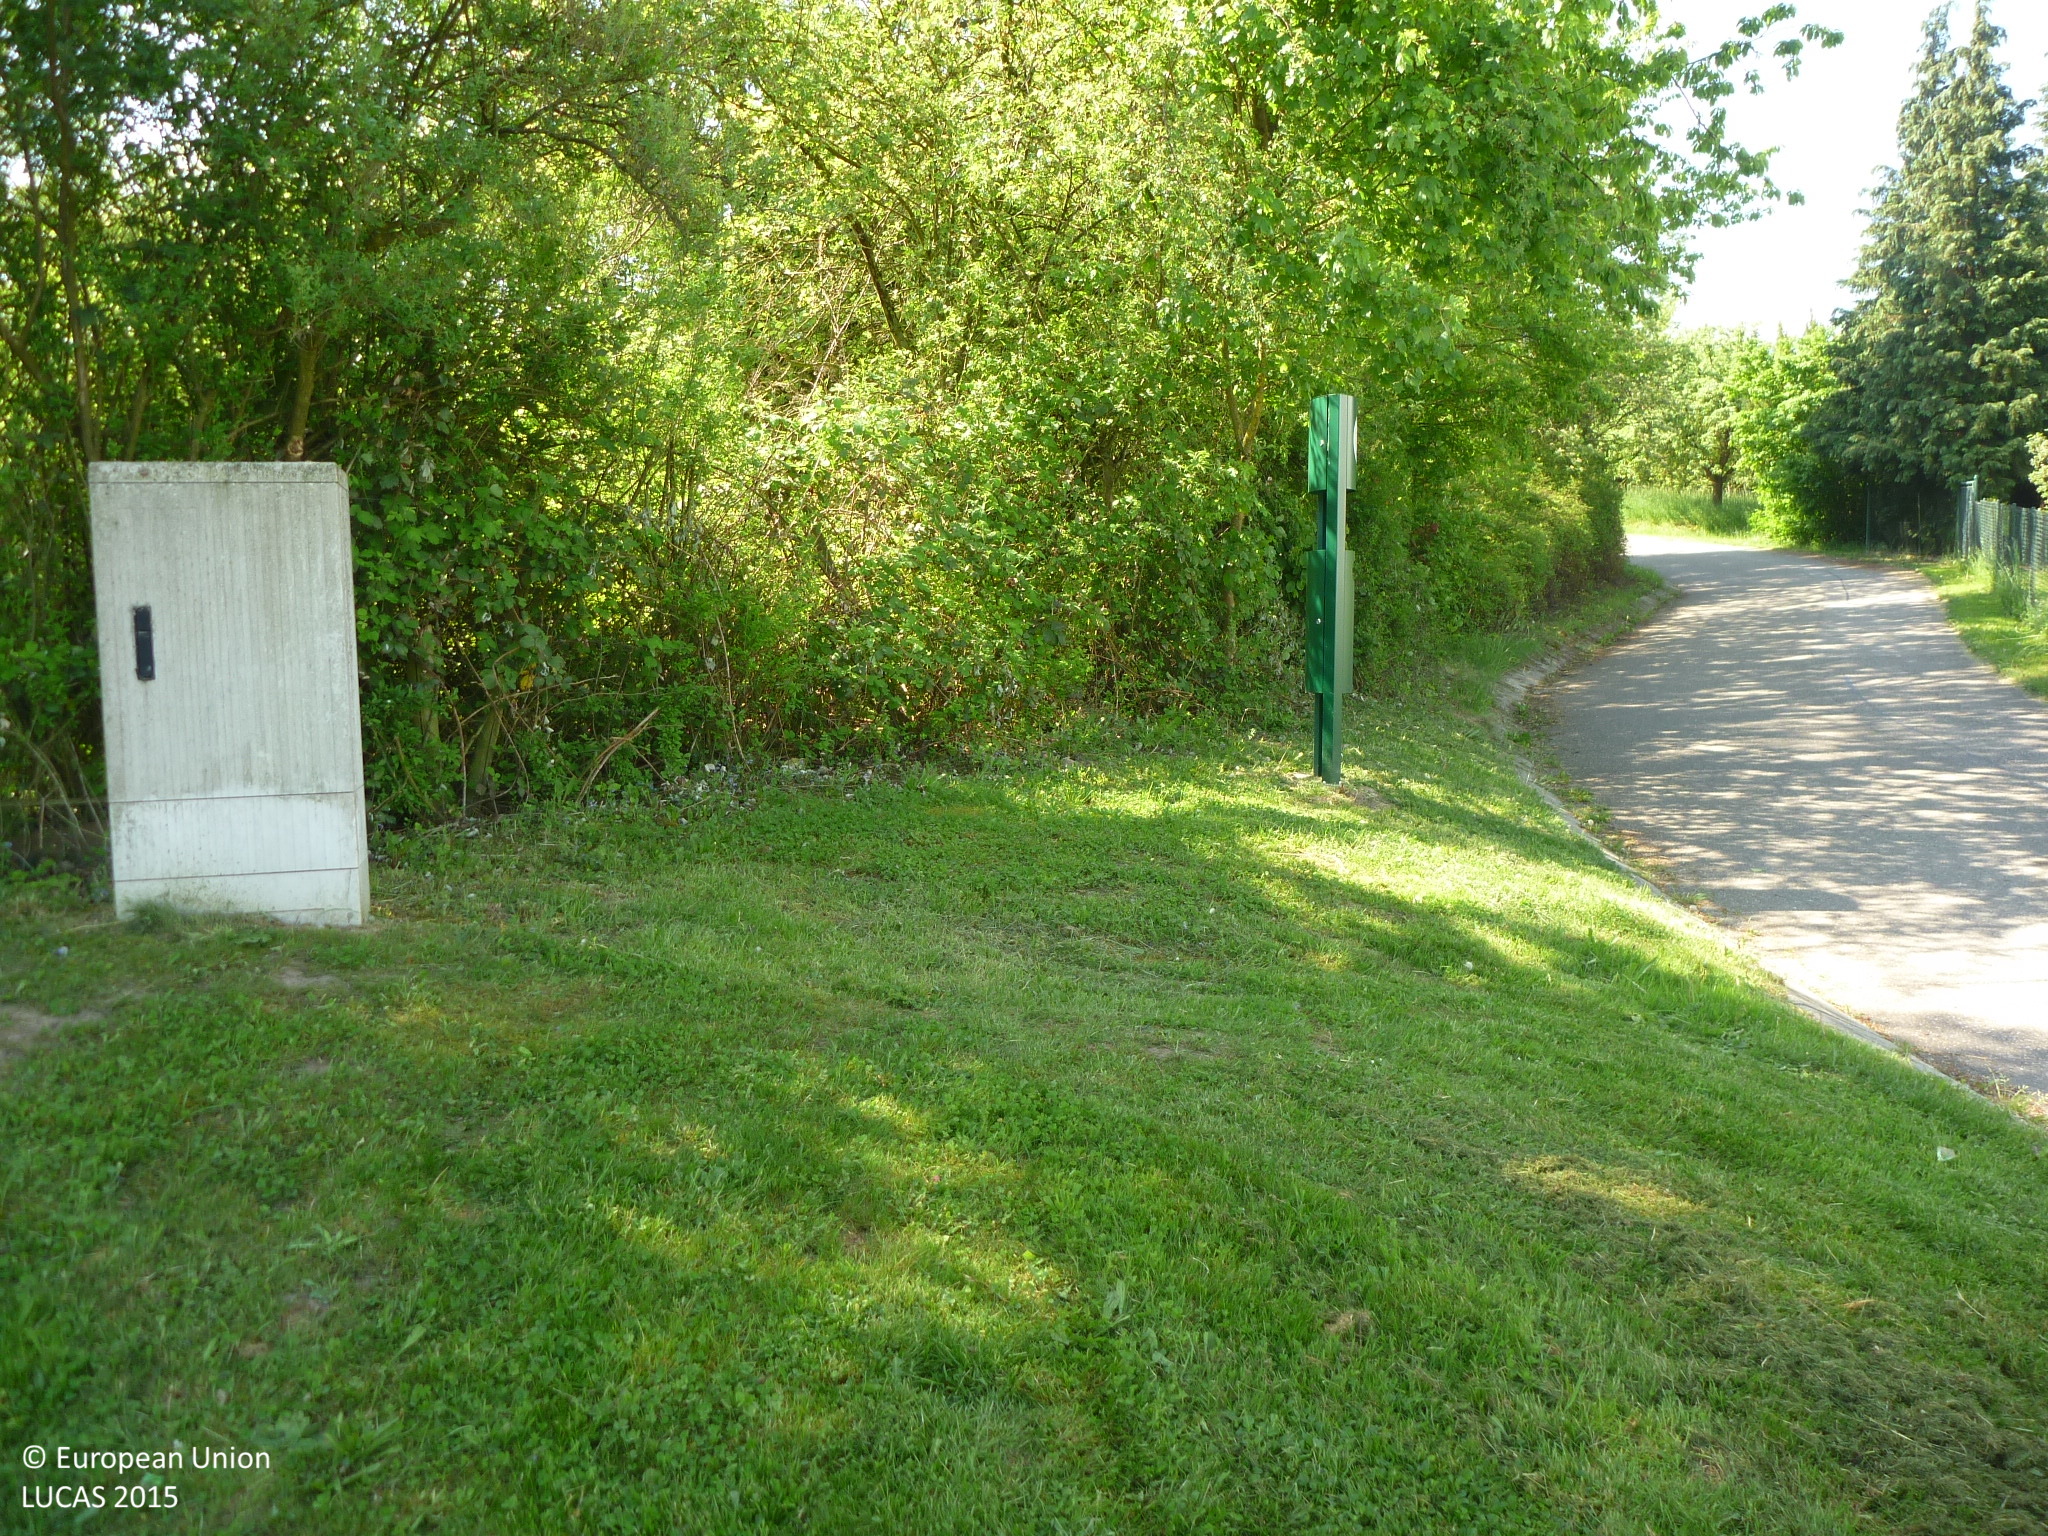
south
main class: Grassland
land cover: Grassland without tree/shrub cover
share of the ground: > 75 %
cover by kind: herbaceous plants 100 %
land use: Community services
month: May
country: DE
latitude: 49.0670
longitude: 9.3023
